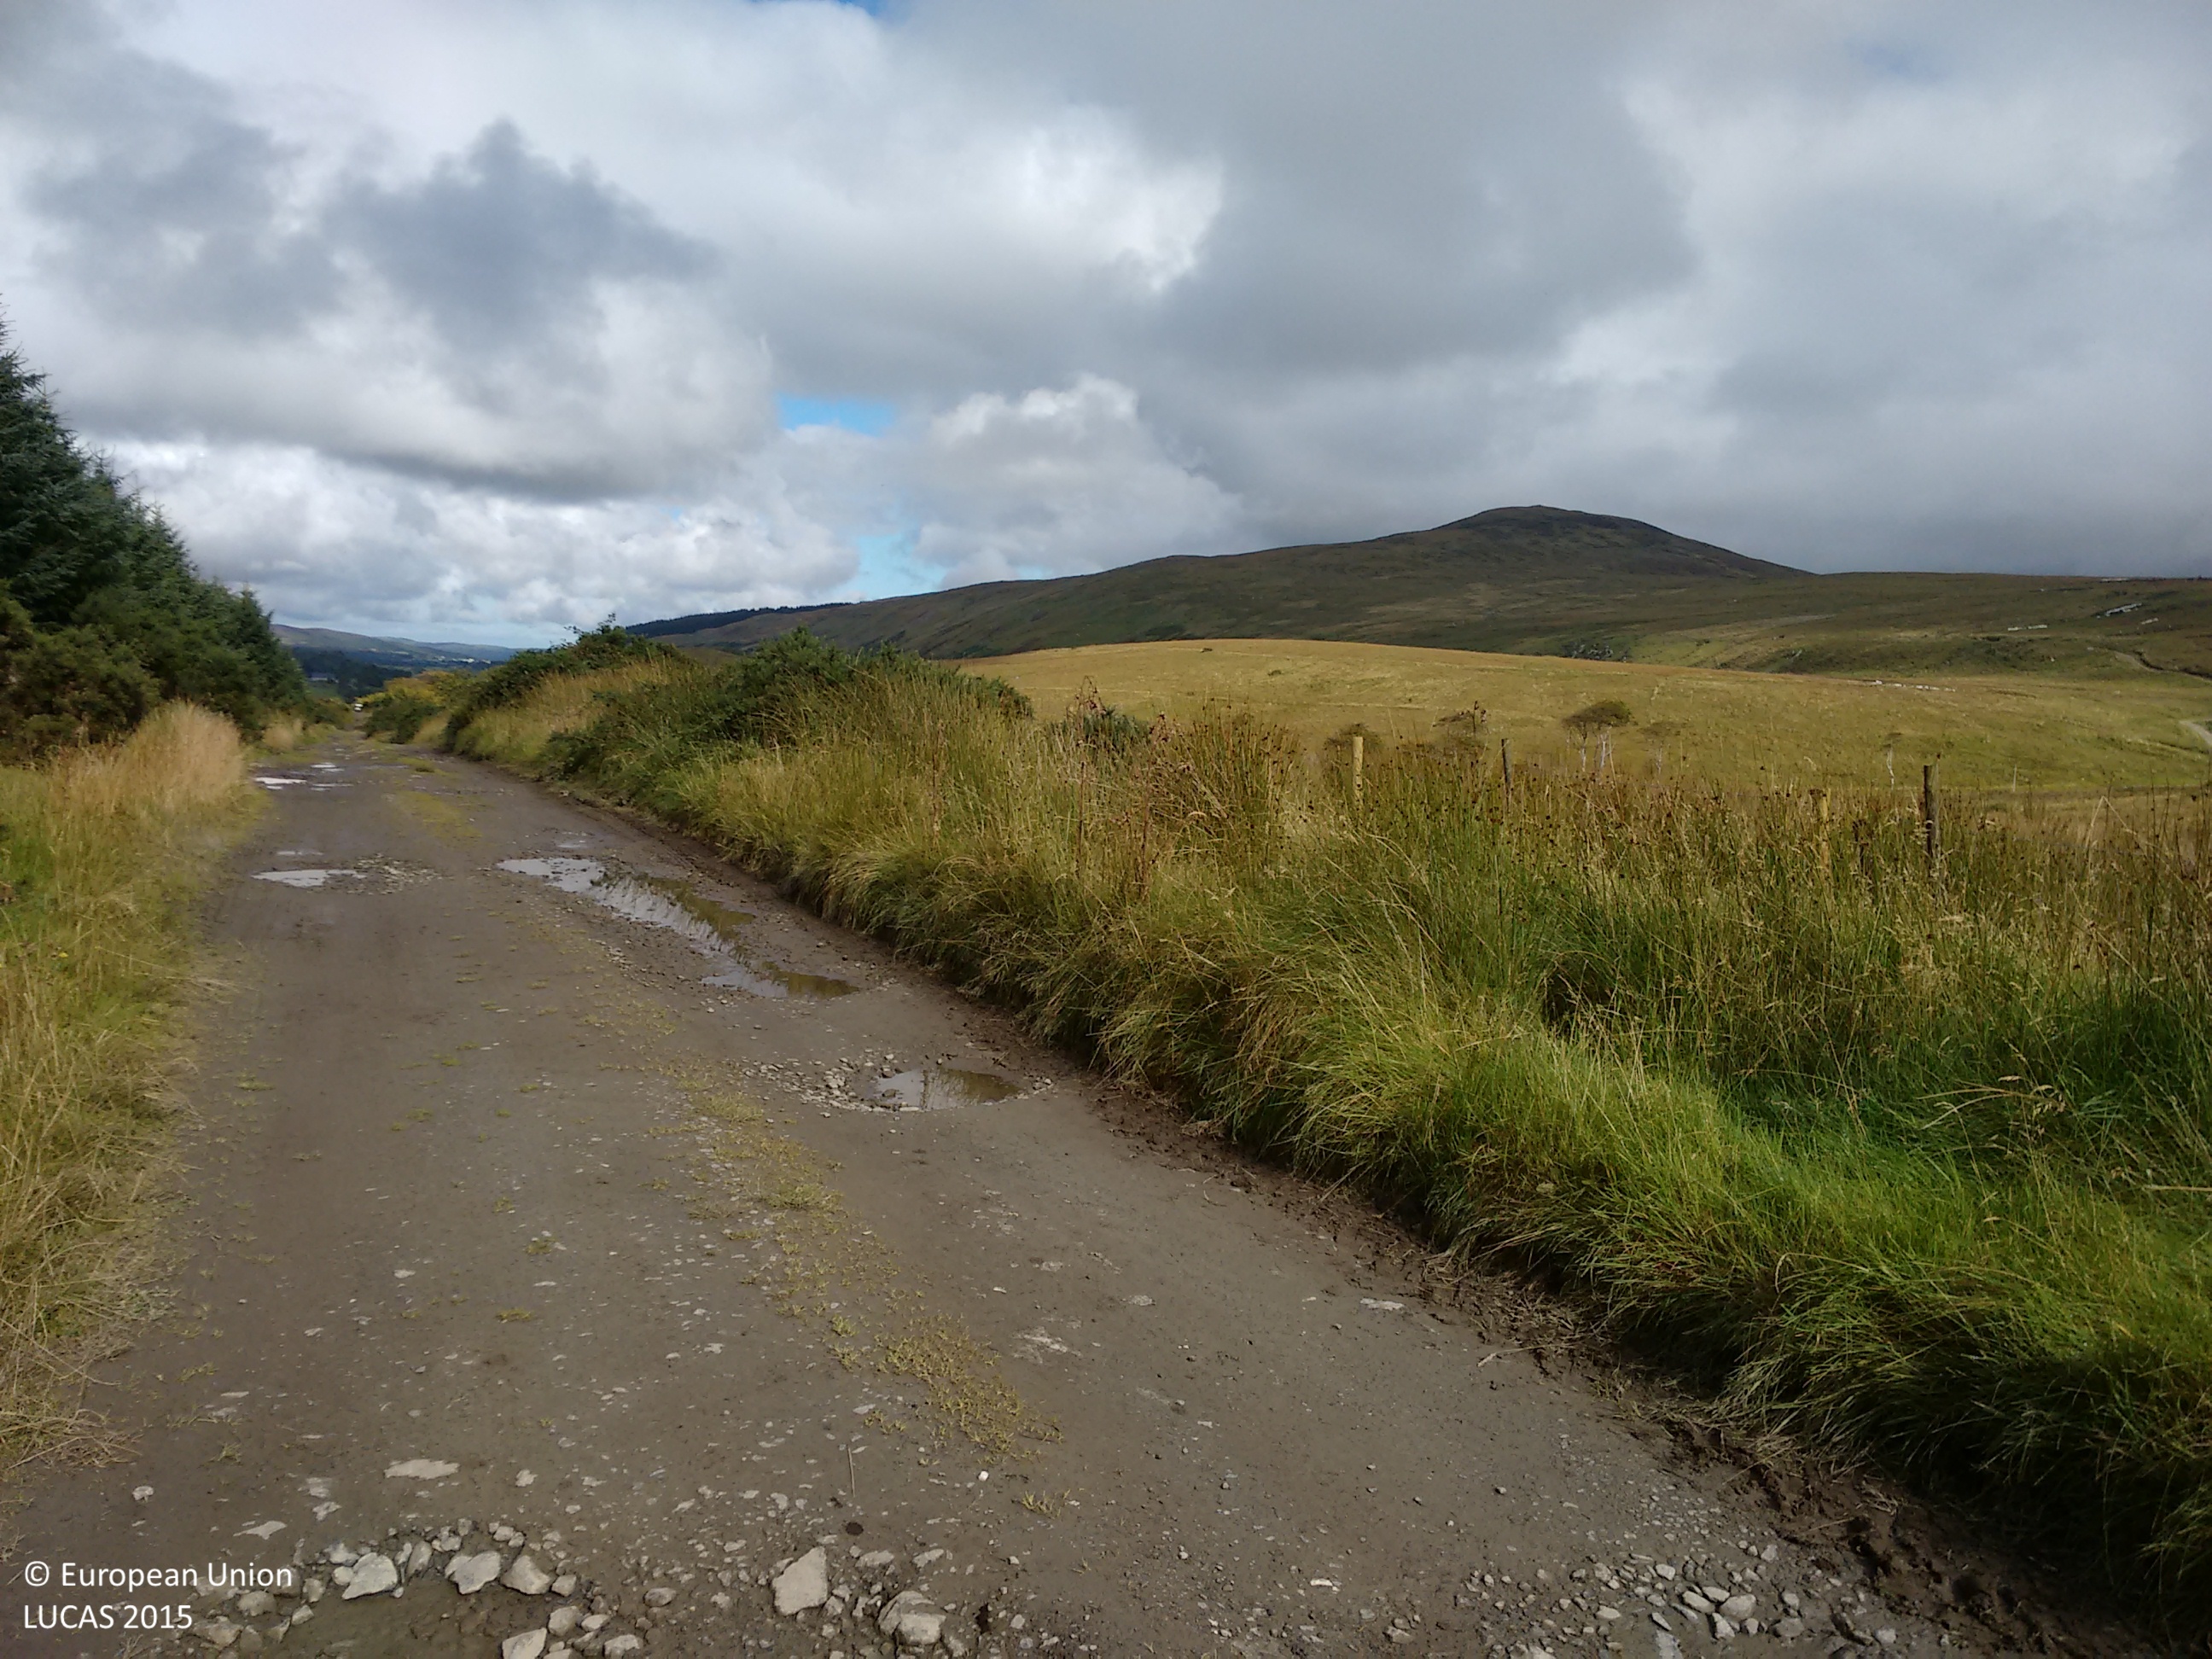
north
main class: Woodland
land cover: Spruce dominated coniferous woodland
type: exotic forest
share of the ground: > 75 %
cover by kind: coniferous forest trees 100 %
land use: Forestry
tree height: > 5 m
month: September
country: IE
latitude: 55.1726
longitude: -7.2428
